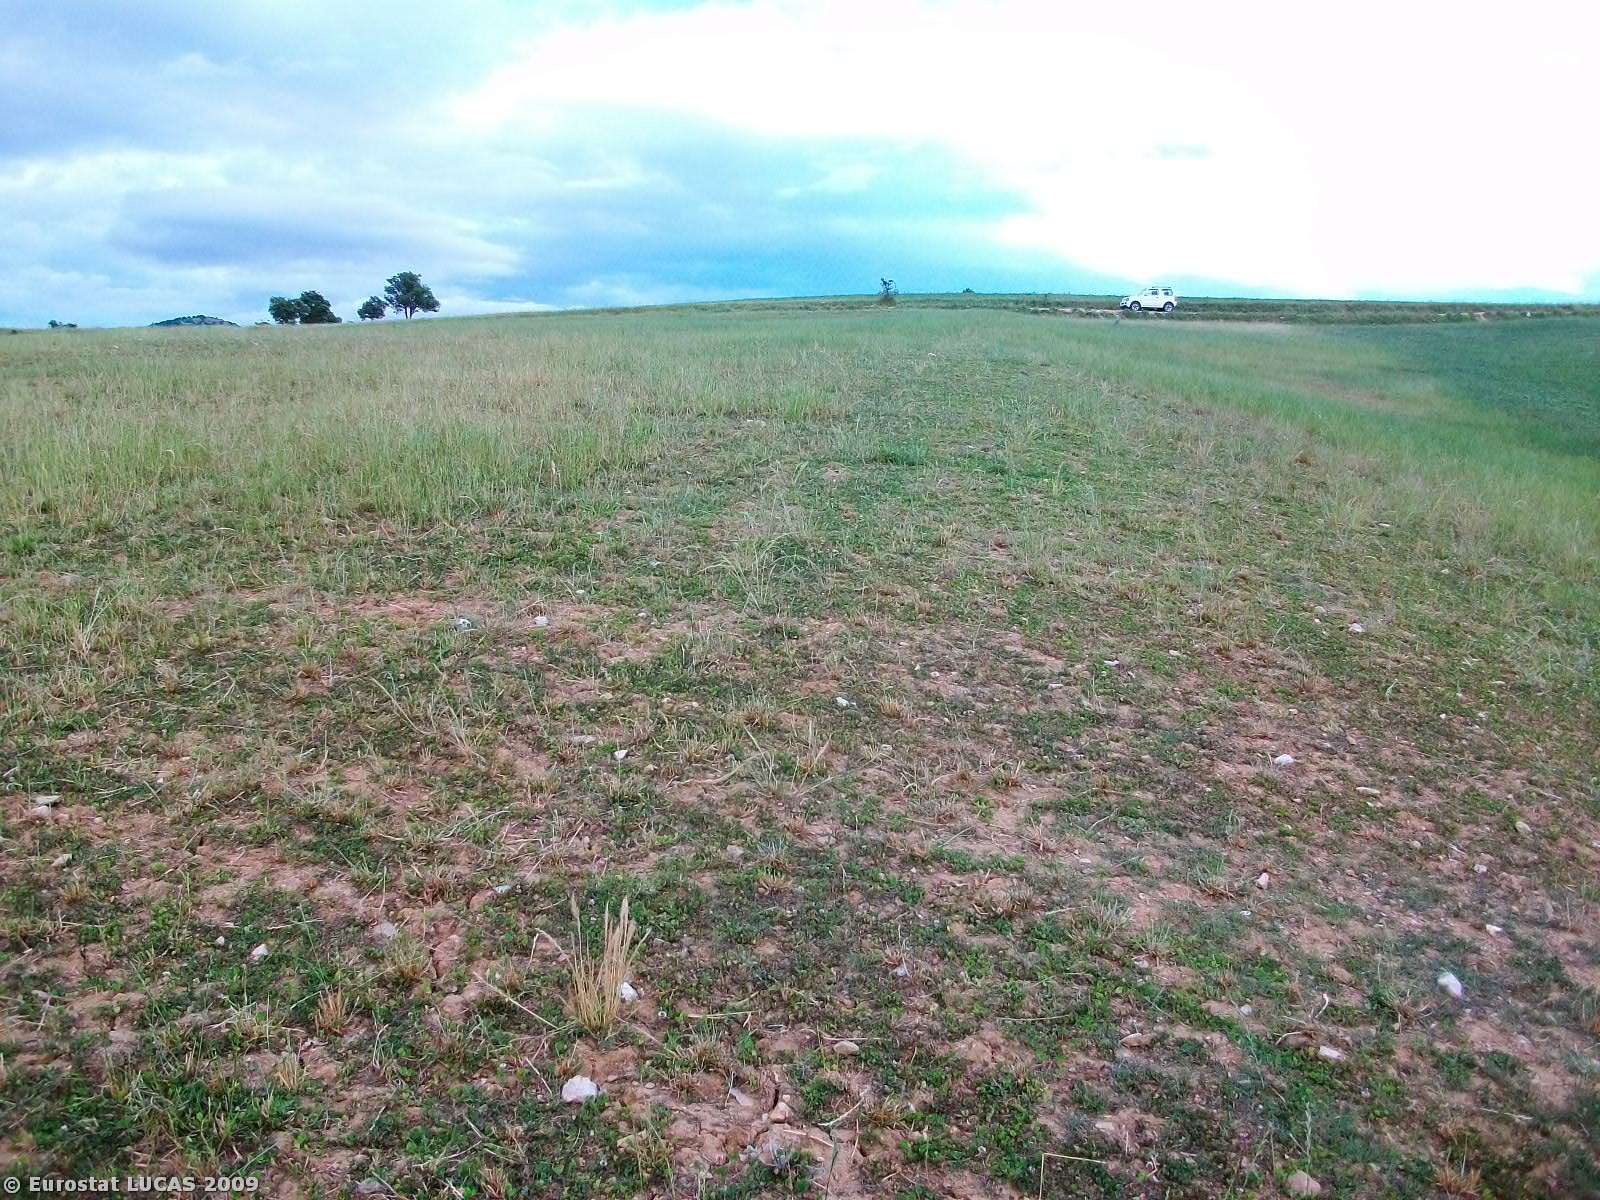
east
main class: Grassland
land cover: Spontaneously vegetated surfaces
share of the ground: > 75 %
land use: Fallow land
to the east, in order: Spontaneously vegetated surfaces; Grass margins; Tracks; Grass margins; Spontaneously vegetated surfaces; Grass margins; Paved roads, cycling and walking lanes; Grass margins; Spontaneously vegetated surfaces; Tracks; Grass margins; Spontaneously vegetated surfaces
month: June
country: GR
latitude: 39.9038
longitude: 21.7660
